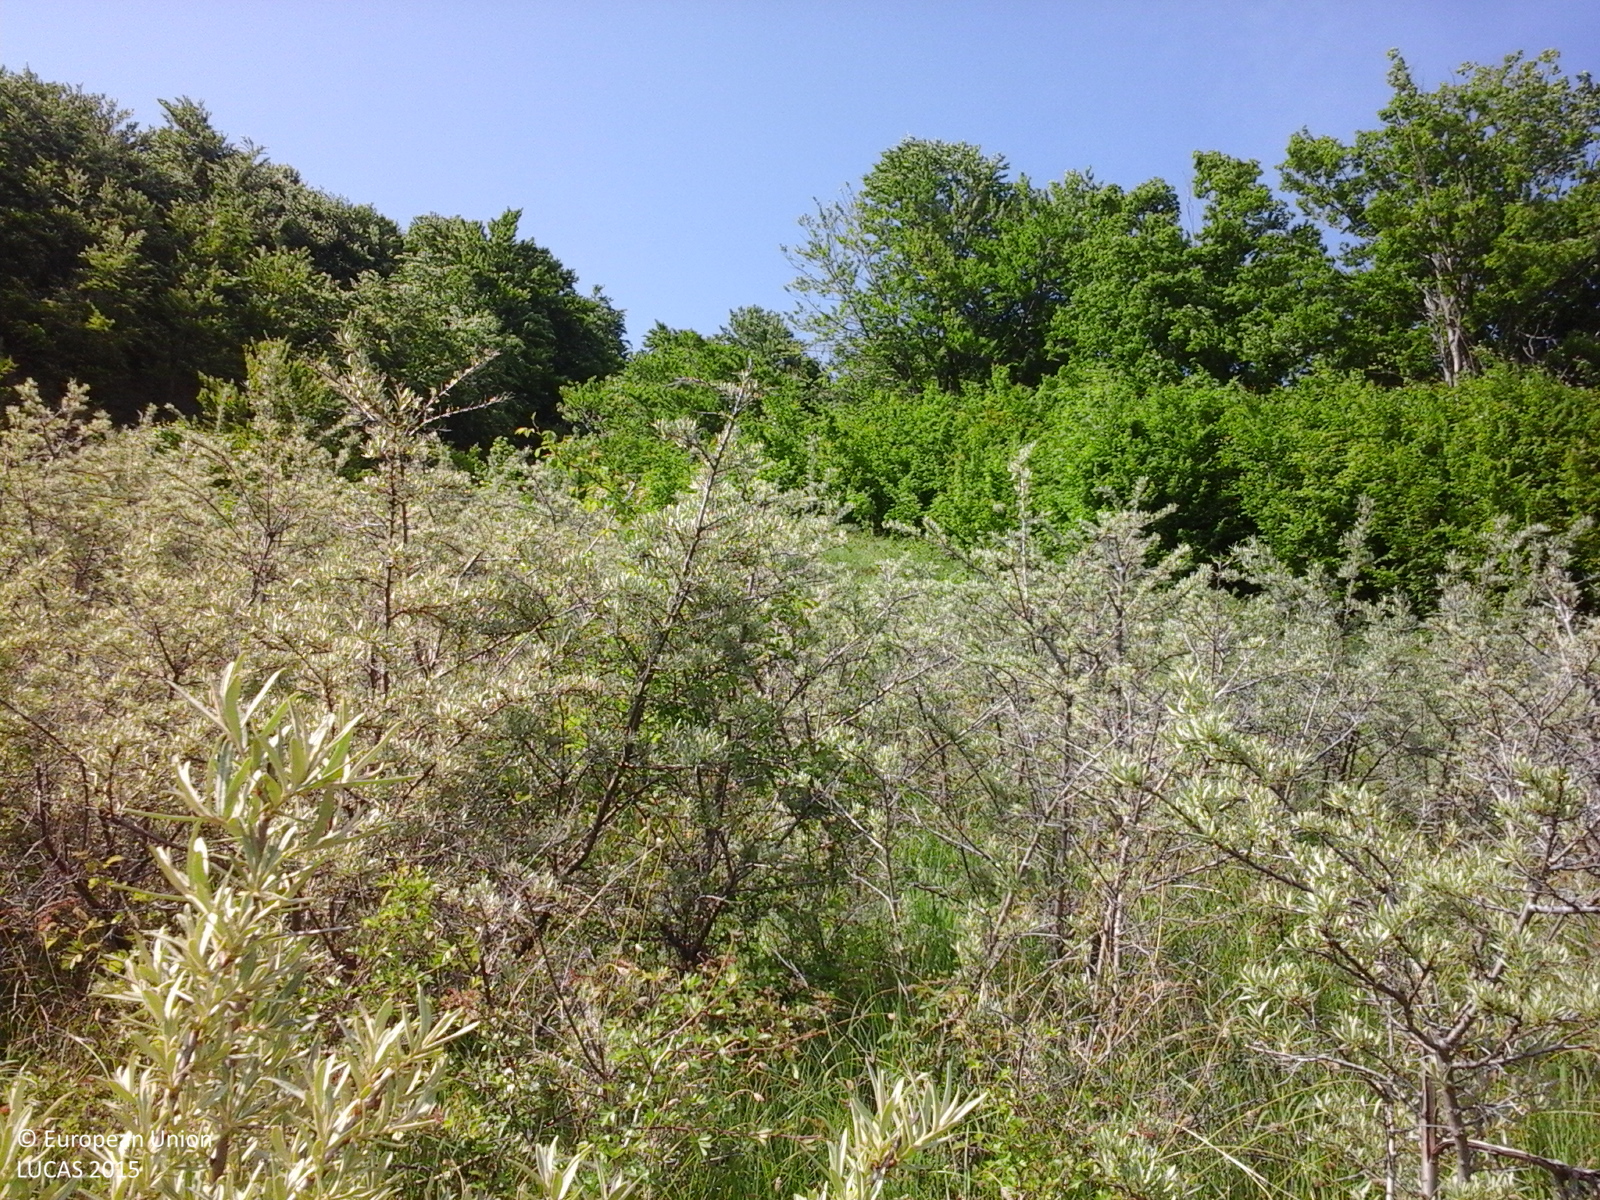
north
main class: Shrubland
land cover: Shrubland with sparse tree cover
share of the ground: > 75 %
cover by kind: shrubs 95 %, broadleaved forest trees 5 %
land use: Forestry
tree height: < 5 m
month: May
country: RO
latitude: 45.4228
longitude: 26.2862
